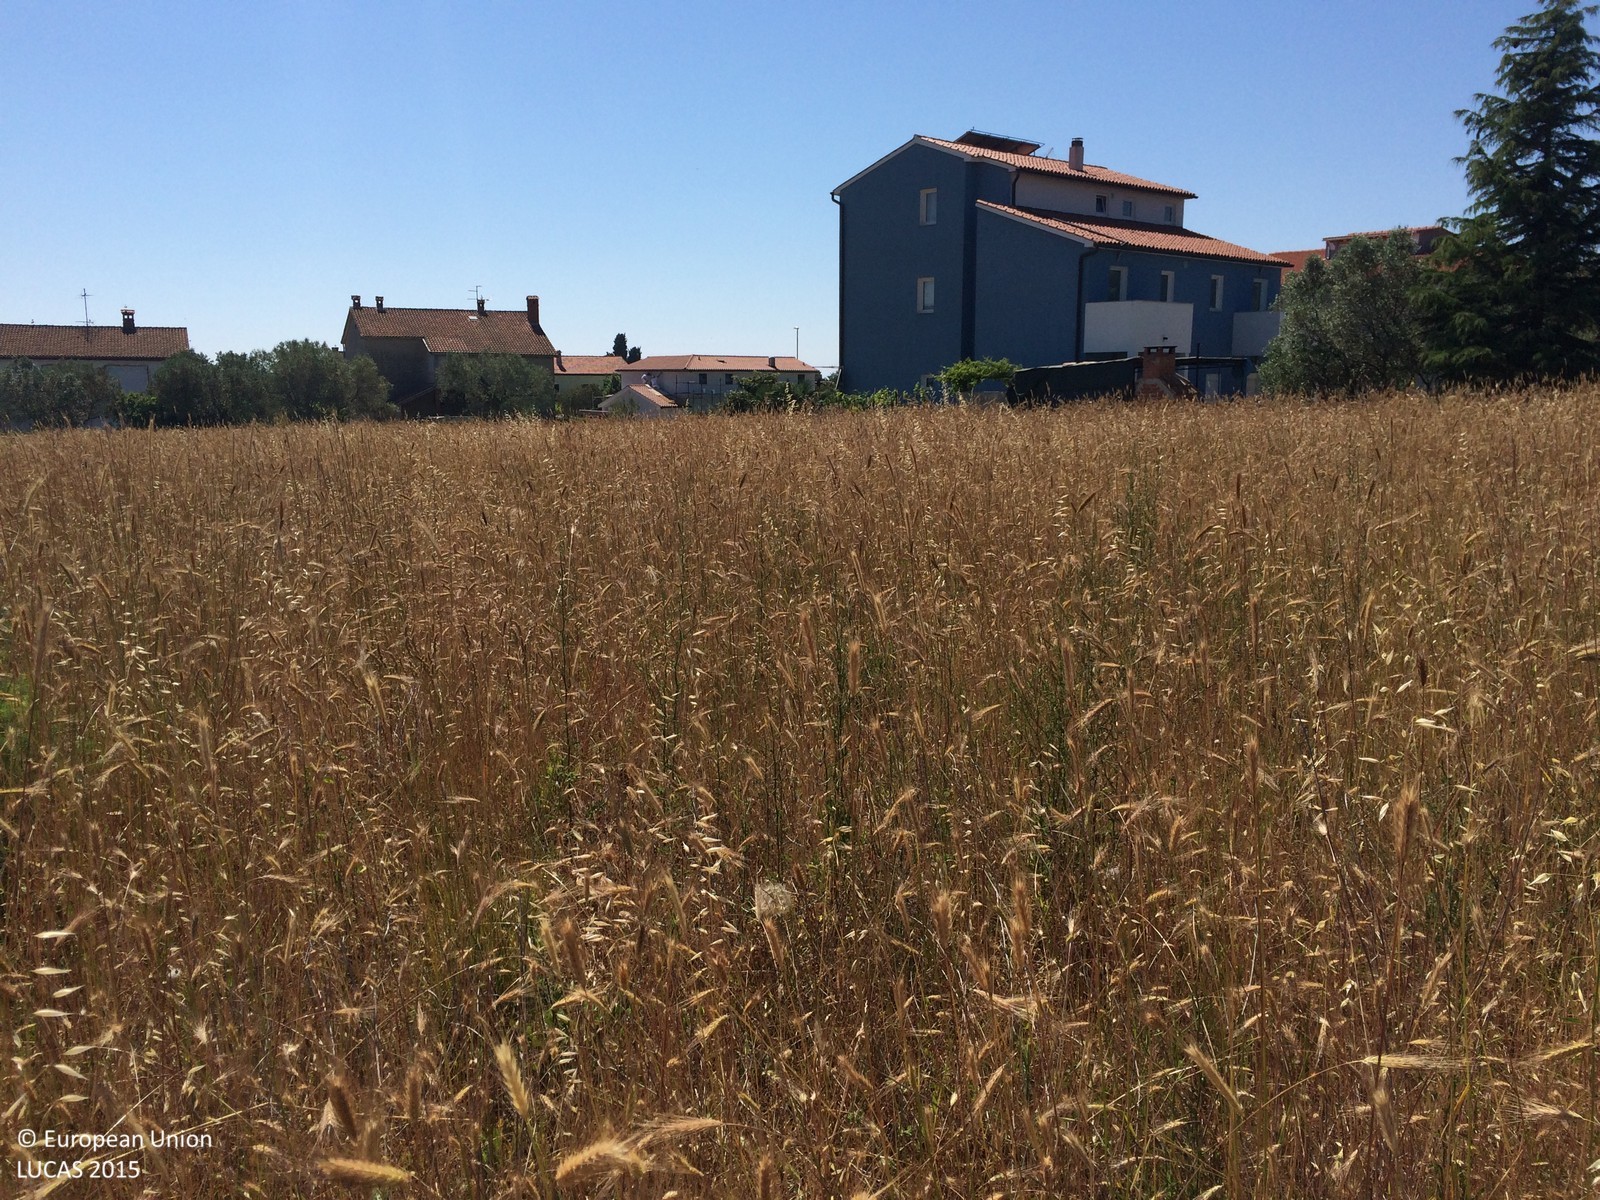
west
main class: Grassland
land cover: Grassland without tree/shrub cover
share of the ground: > 75 %
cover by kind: herbaceous plants 100 %
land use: Agriculture (excluding fallow land and kitchen gardens)
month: June
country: HR
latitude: 44.9305
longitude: 13.8081
